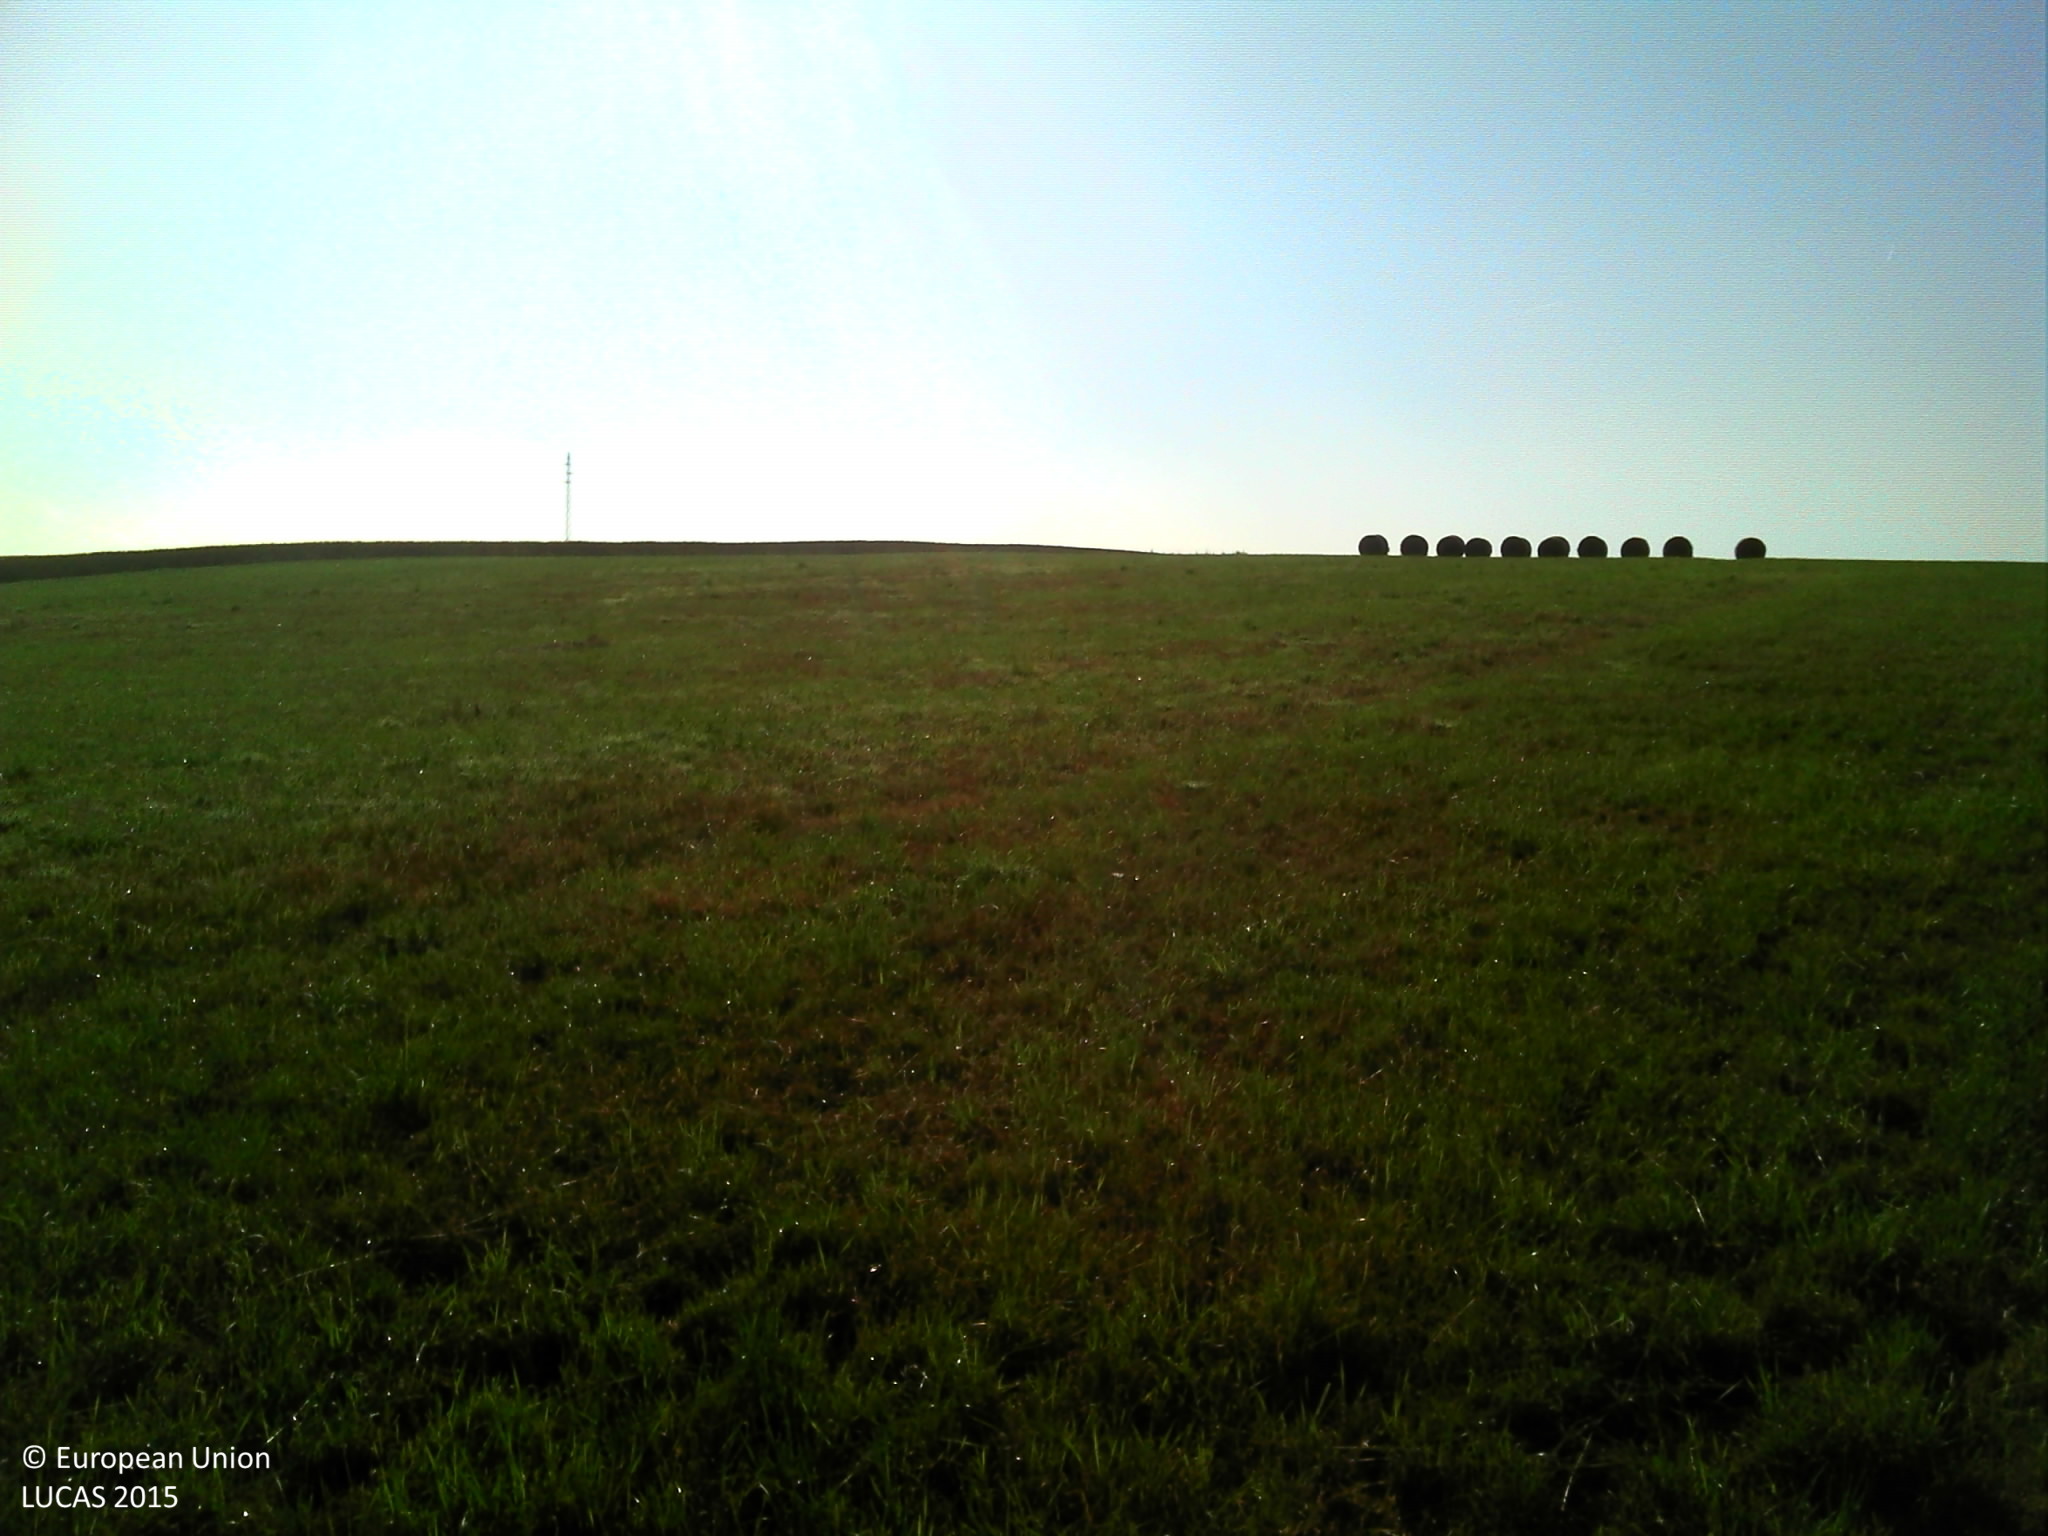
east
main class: Grassland
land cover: Grassland without tree/shrub cover
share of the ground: > 75 %
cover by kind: herbaceous plants 100 %
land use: Agriculture (excluding fallow land and kitchen gardens)
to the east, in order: Grassland without tree/shrub cover; Common wheat; Grassland without tree/shrub cover
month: July
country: BE
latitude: 50.0105
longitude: 5.6309
